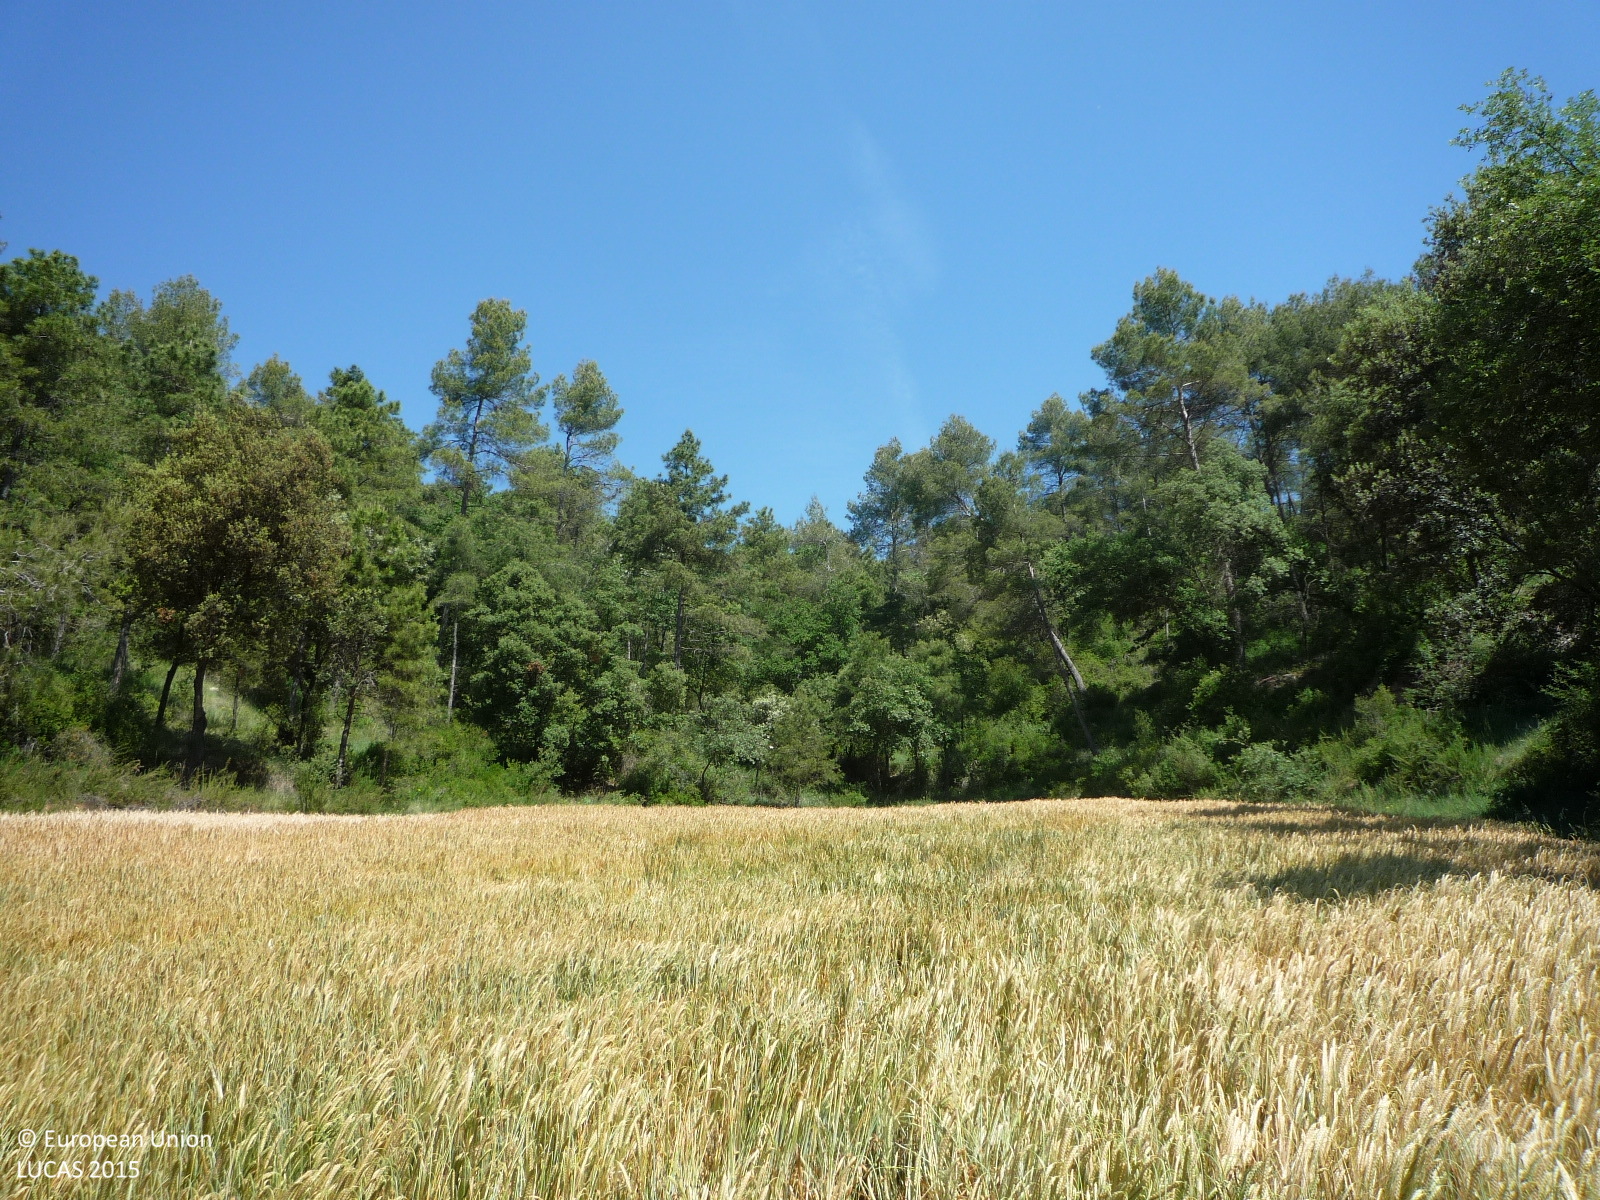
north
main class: Cropland
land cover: Barley
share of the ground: > 75 %
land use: Agriculture (excluding fallow land and kitchen gardens)
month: May
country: ES
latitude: 41.9356
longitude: 1.9698
